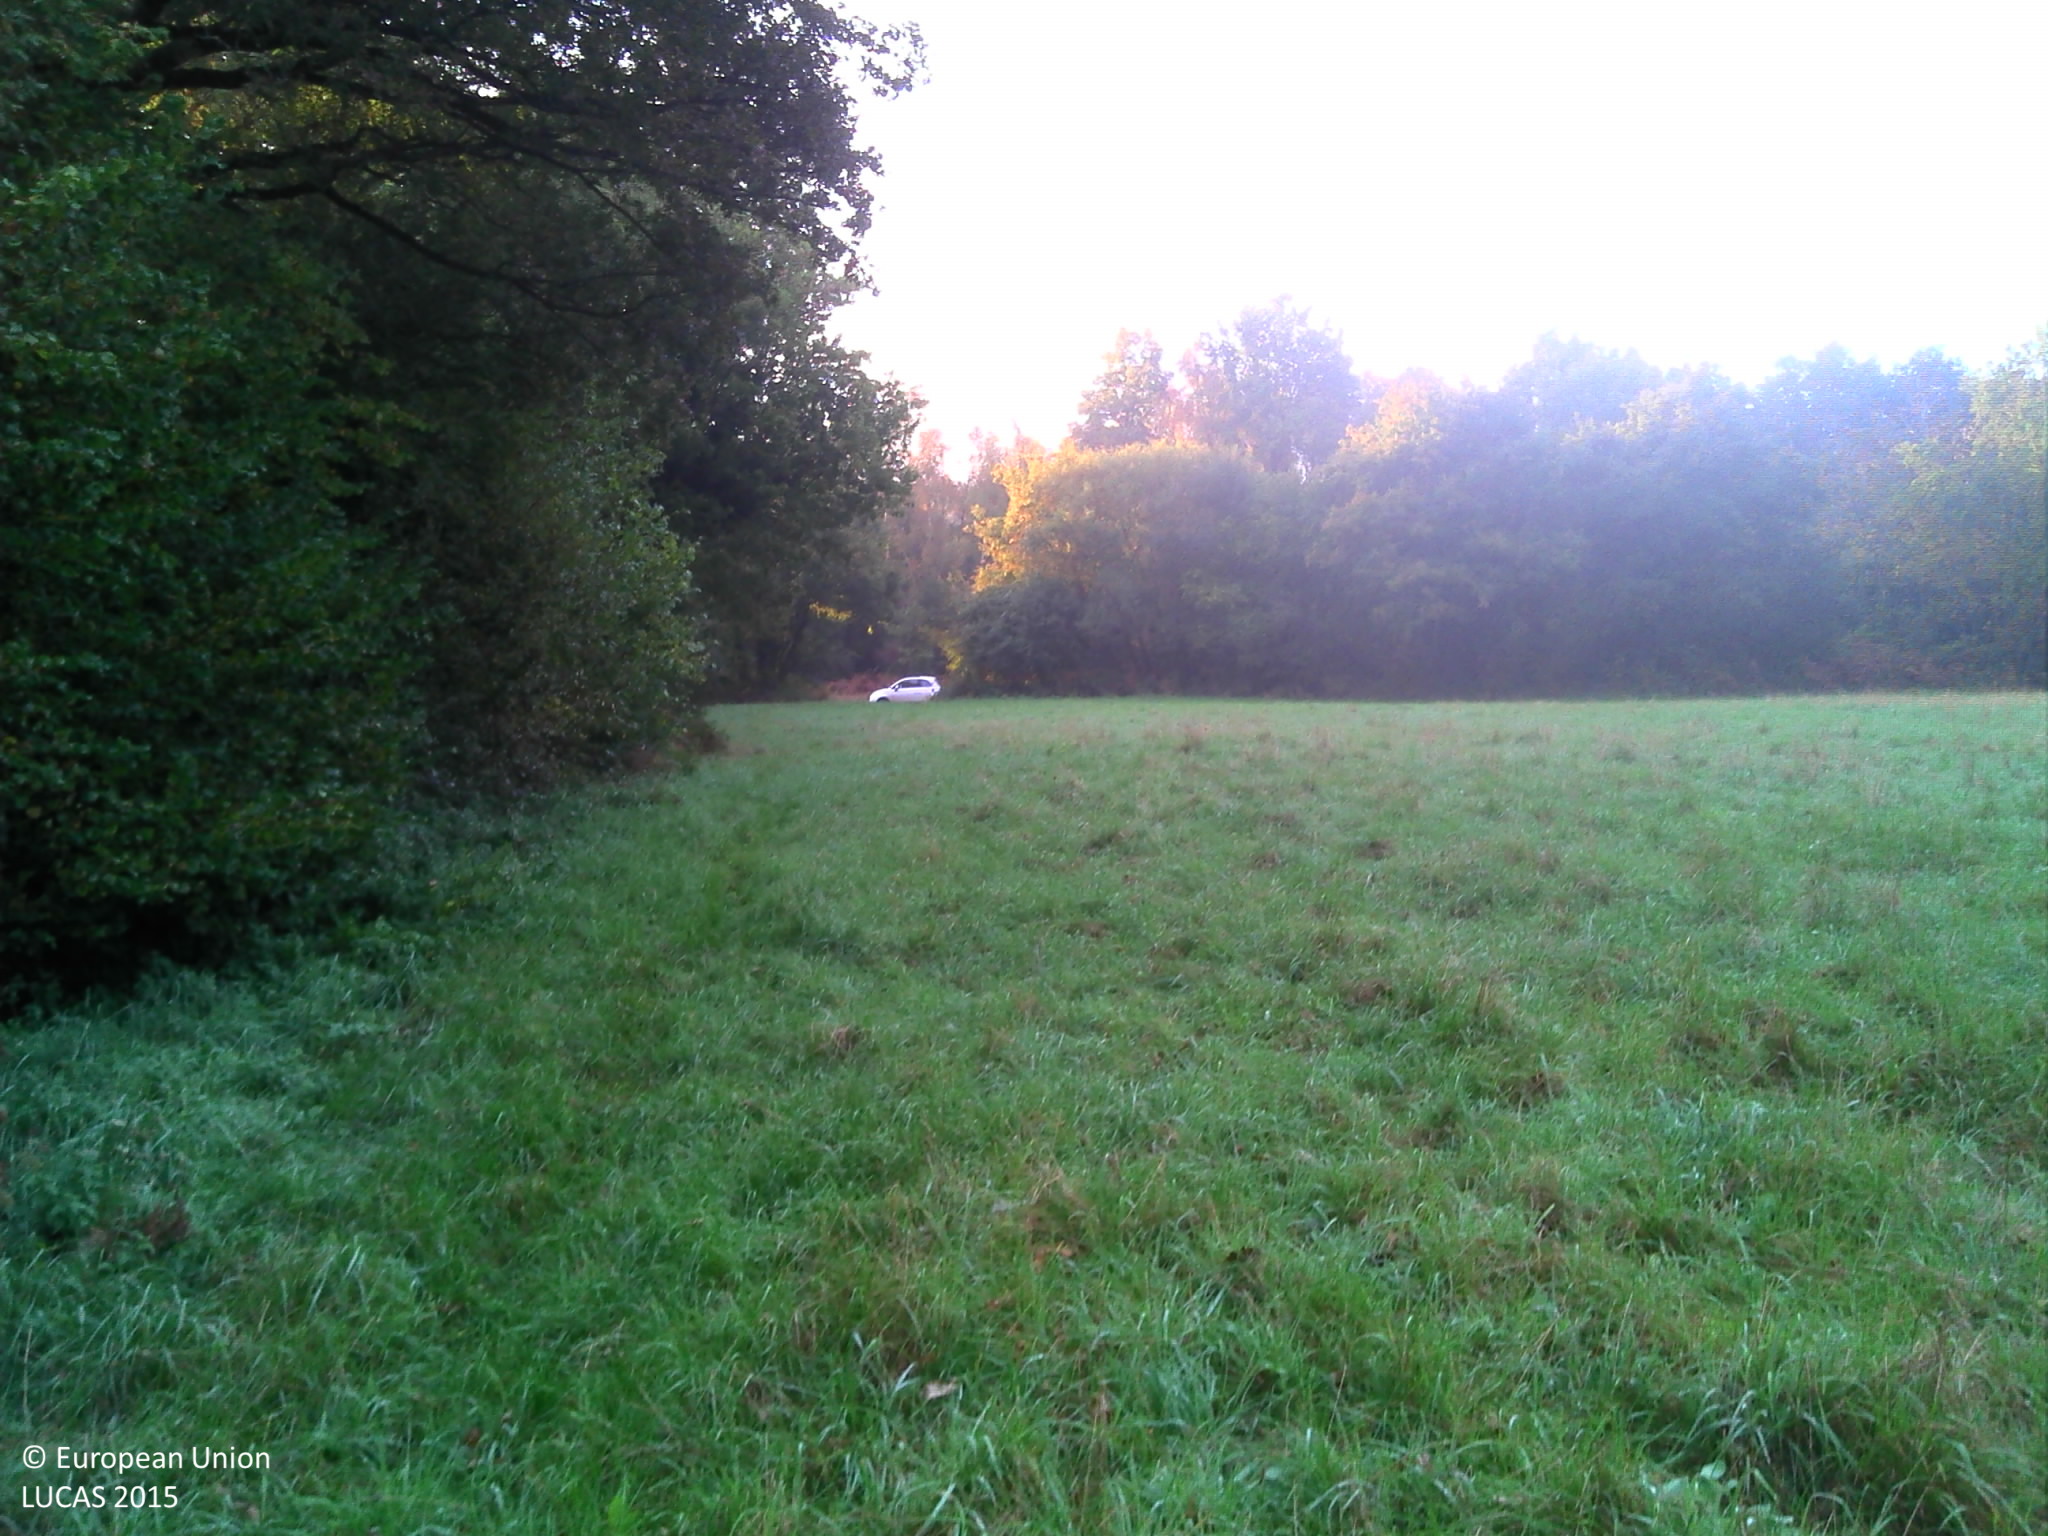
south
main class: Grassland
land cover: Spontaneously vegetated surfaces
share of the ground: > 75 %
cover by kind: herbaceous plants 95 %, shrubs 5 %
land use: Semi-natural and natural areas not in use
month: October
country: FR
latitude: 47.6600
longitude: -2.2917
